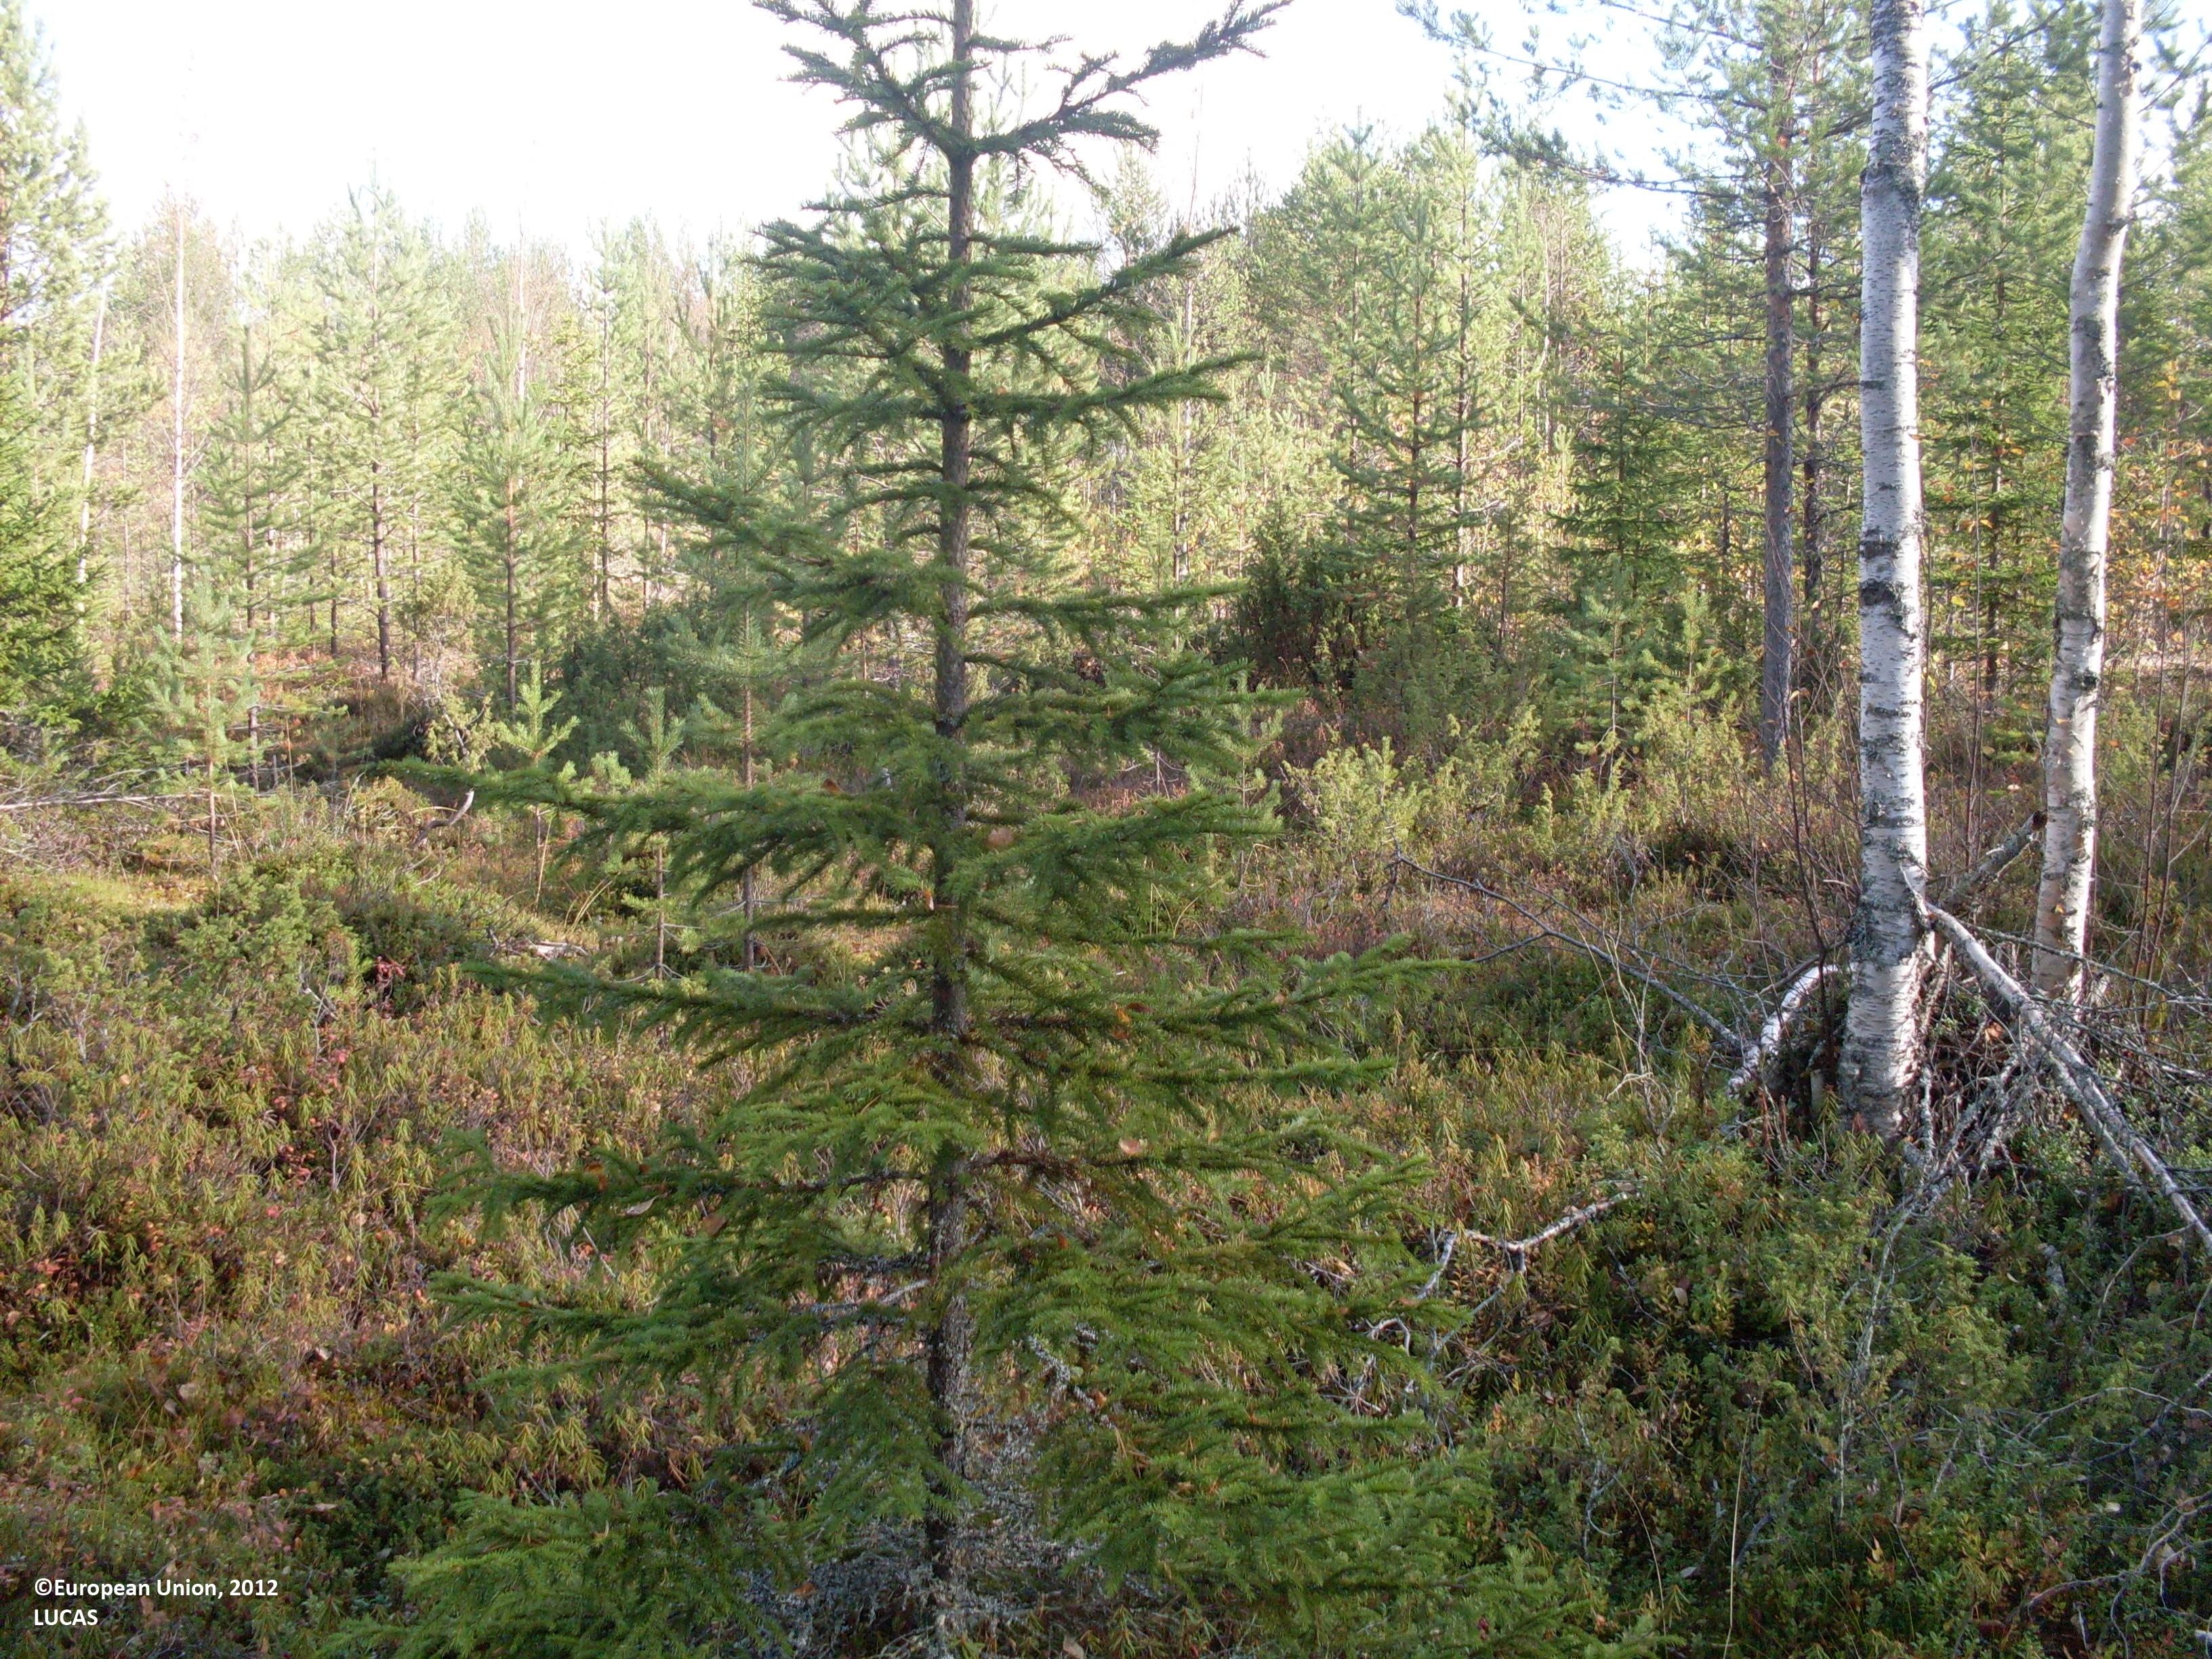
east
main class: Woodland
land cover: Pine dominated mixed woodland
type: boreal forest
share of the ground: 10 - 25 %
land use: Forestry
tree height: > 5 m
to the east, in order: Pine dominated mixed woodland; Ditches and canals; Paved roads, cycling and walking lanes; Ditches and canals; Pine dominated mixed woodland; Ditches and canals; Pine dominated coniferous woodland; Ditches and canals; Pine dominated coniferous woodland; Ditches and canals; Pine dominated coniferous woodland
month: September
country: FI
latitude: 64.7512
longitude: 29.4326
